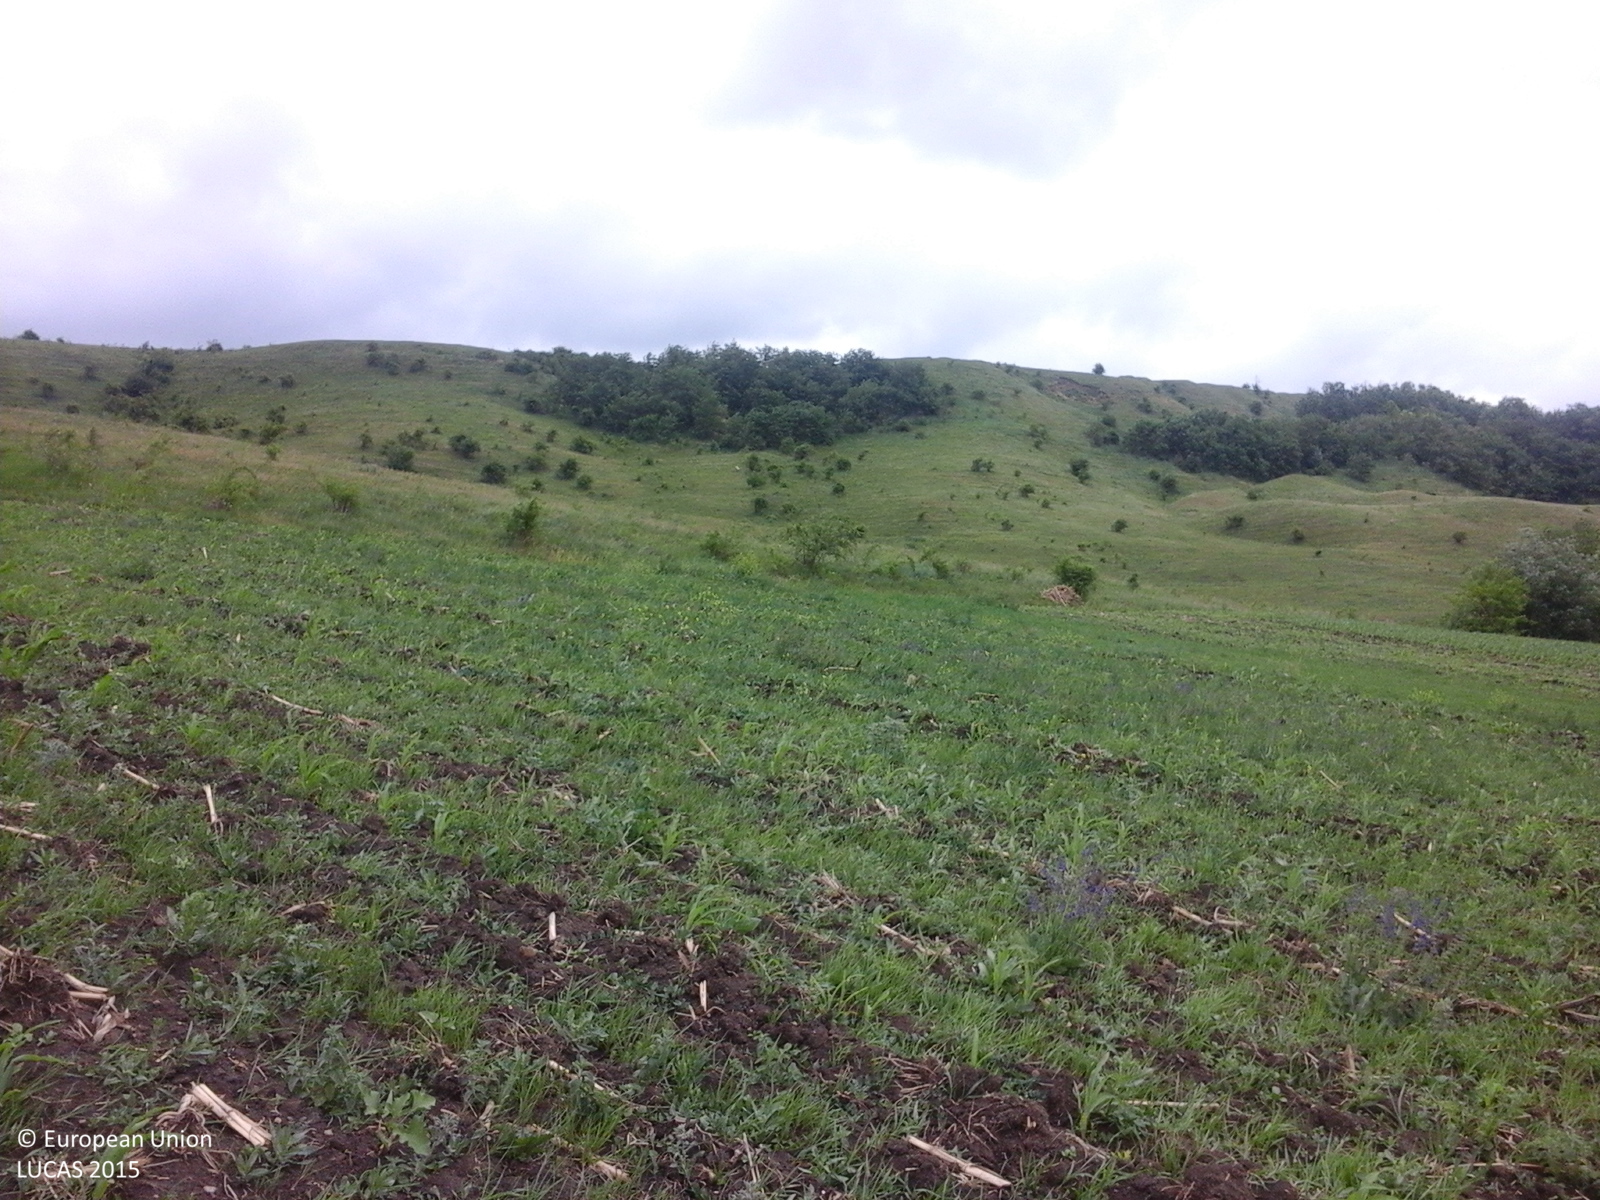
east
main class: Cropland
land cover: Maize
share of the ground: 25 - 50 %
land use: Agriculture (excluding fallow land and kitchen gardens)
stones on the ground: < 10 %
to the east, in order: Maize; Grassland with sparse tree/shrub cover; Ditches and canals; Grassland with sparse tree/shrub cover
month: June
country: RO
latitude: 46.7400
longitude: 26.6708
